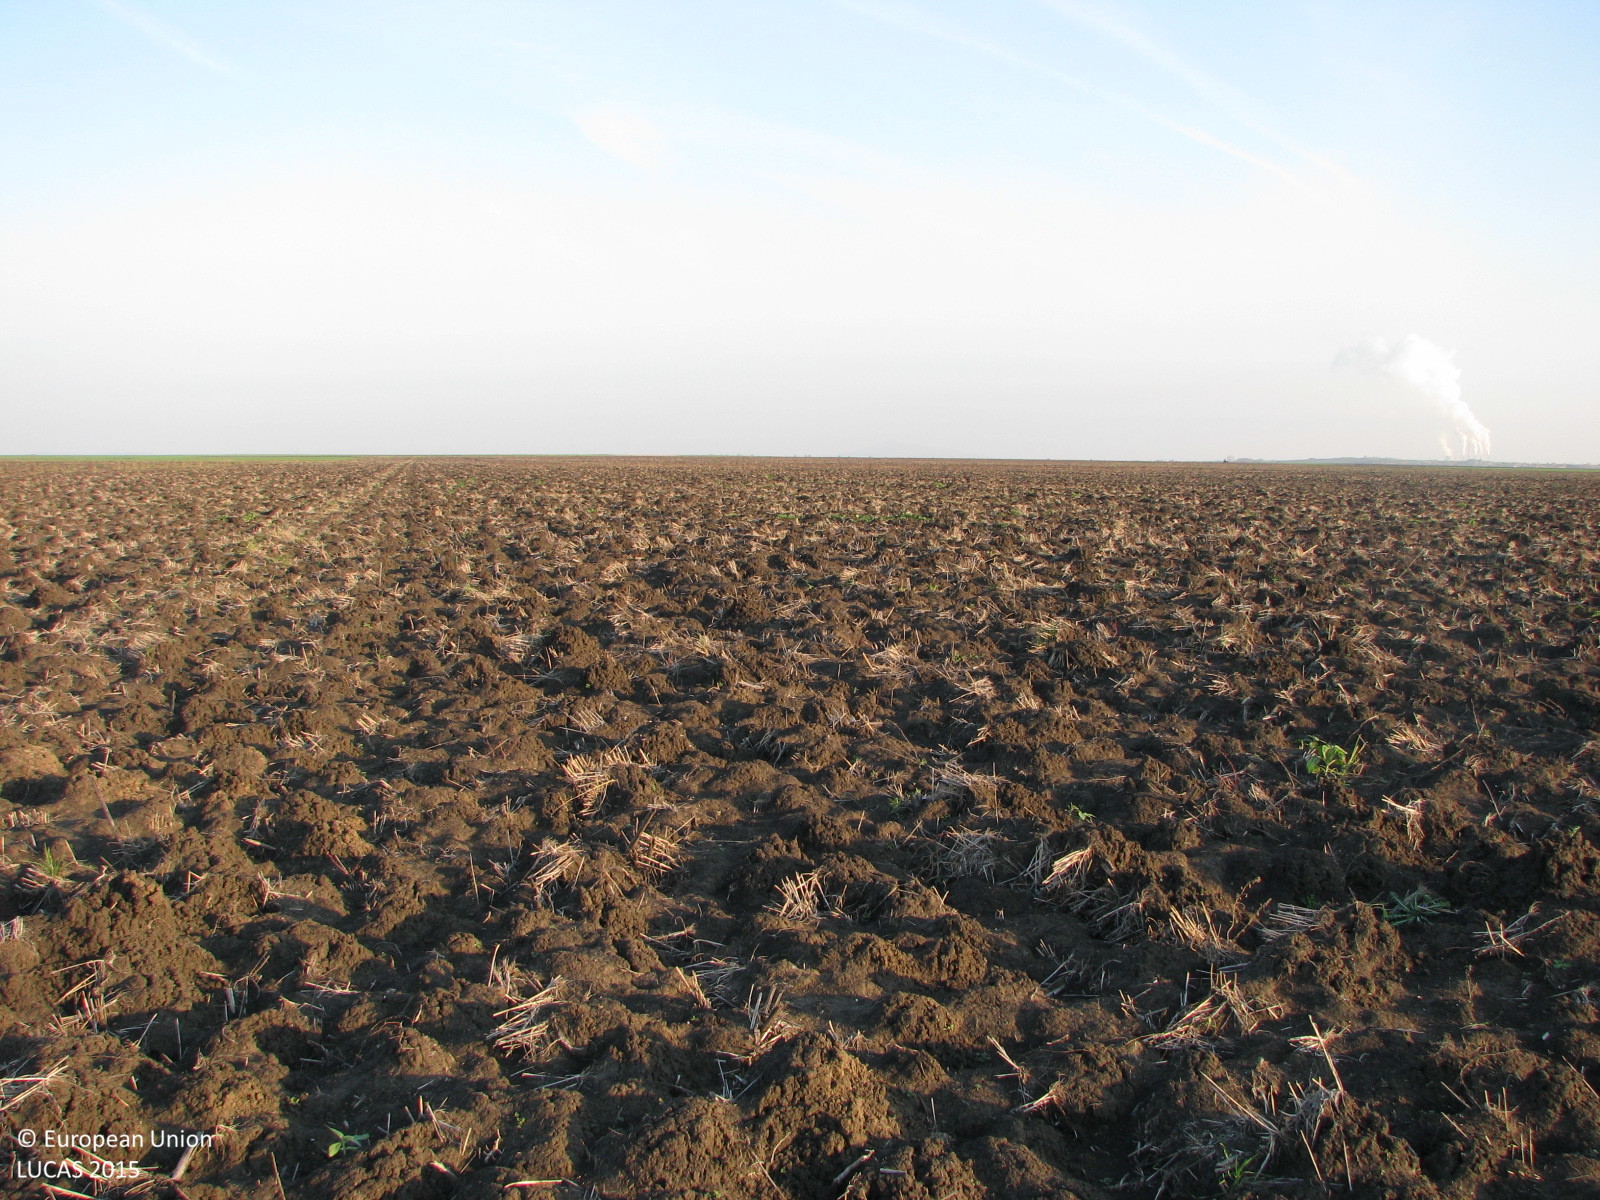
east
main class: Cropland
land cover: Common wheat
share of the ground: < 10 %
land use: Agriculture (excluding fallow land and kitchen gardens)
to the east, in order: Common wheat
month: November
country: BG
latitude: 42.3436
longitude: 26.0168
